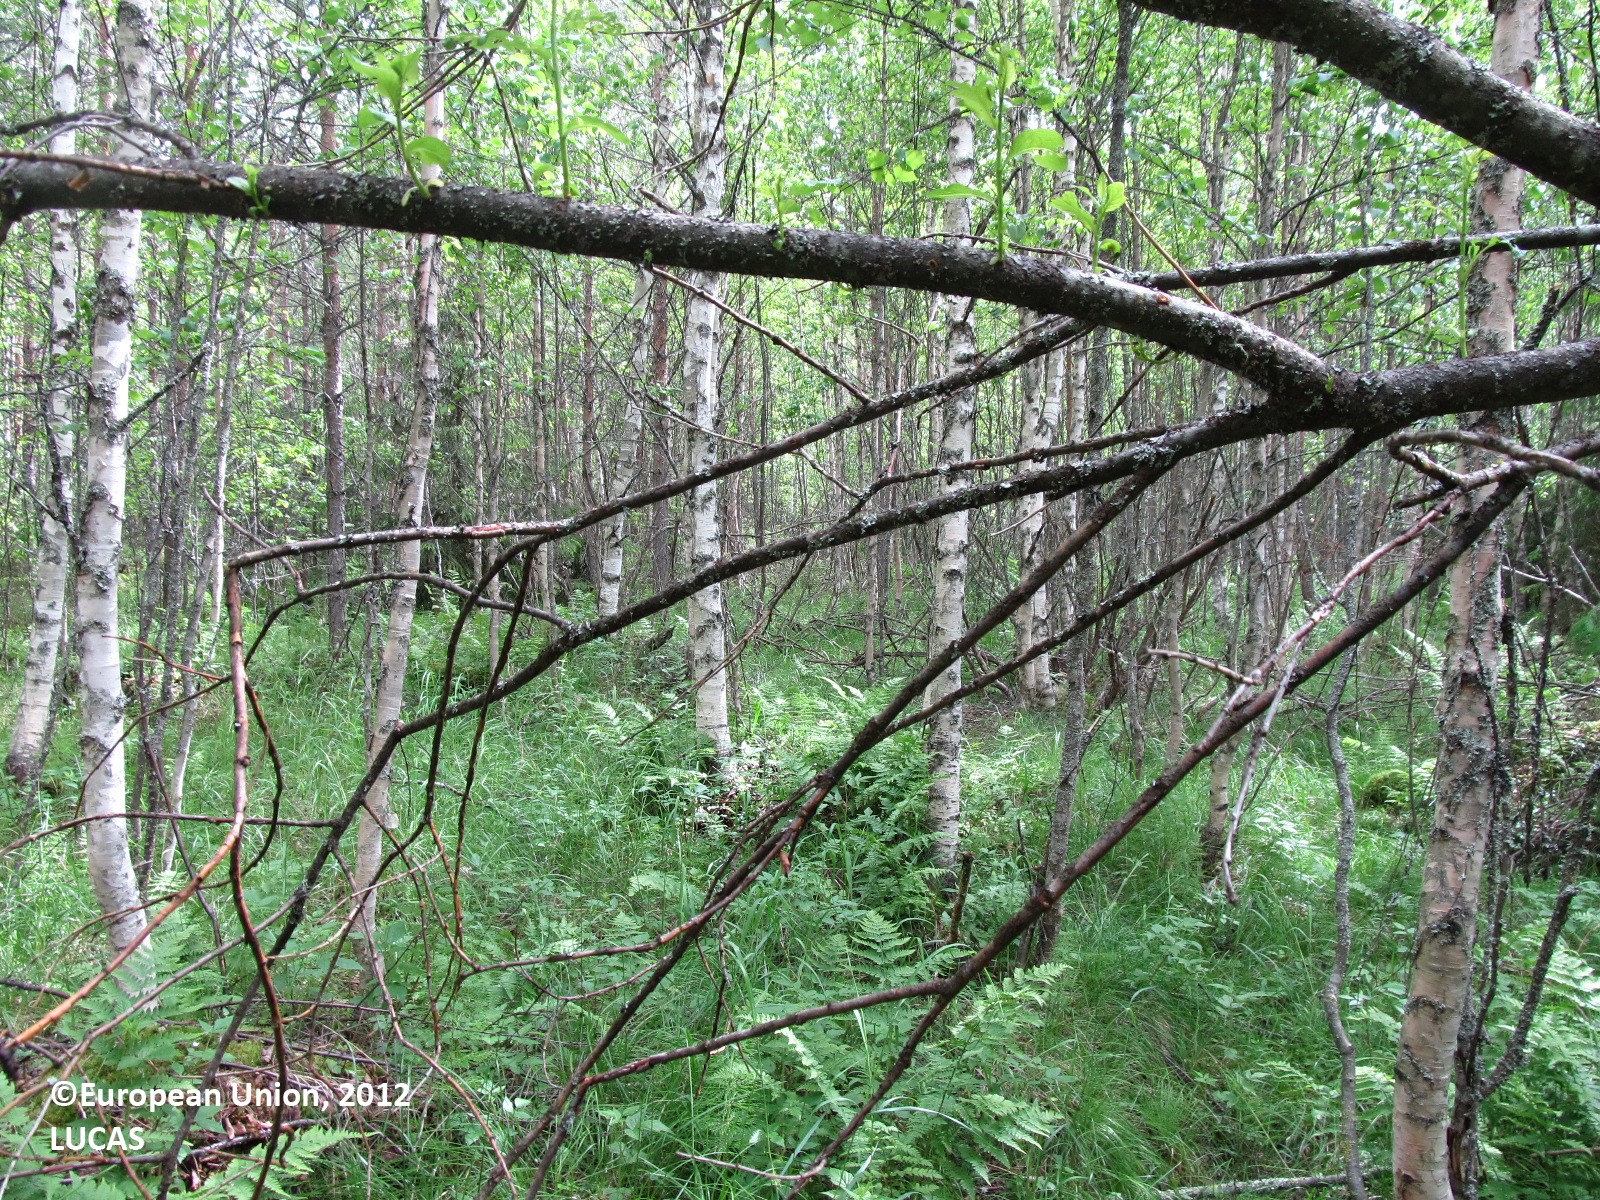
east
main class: Woodland
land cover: Spruce dominated mixed woodland
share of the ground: 50 - 75 %
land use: Forestry
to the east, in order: Spruce dominated mixed woodland; Broadleaved woodland; Pine dominated mixed woodland; Pine dominated coniferous woodland
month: June
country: FI
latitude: 63.2407
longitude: 27.7040
